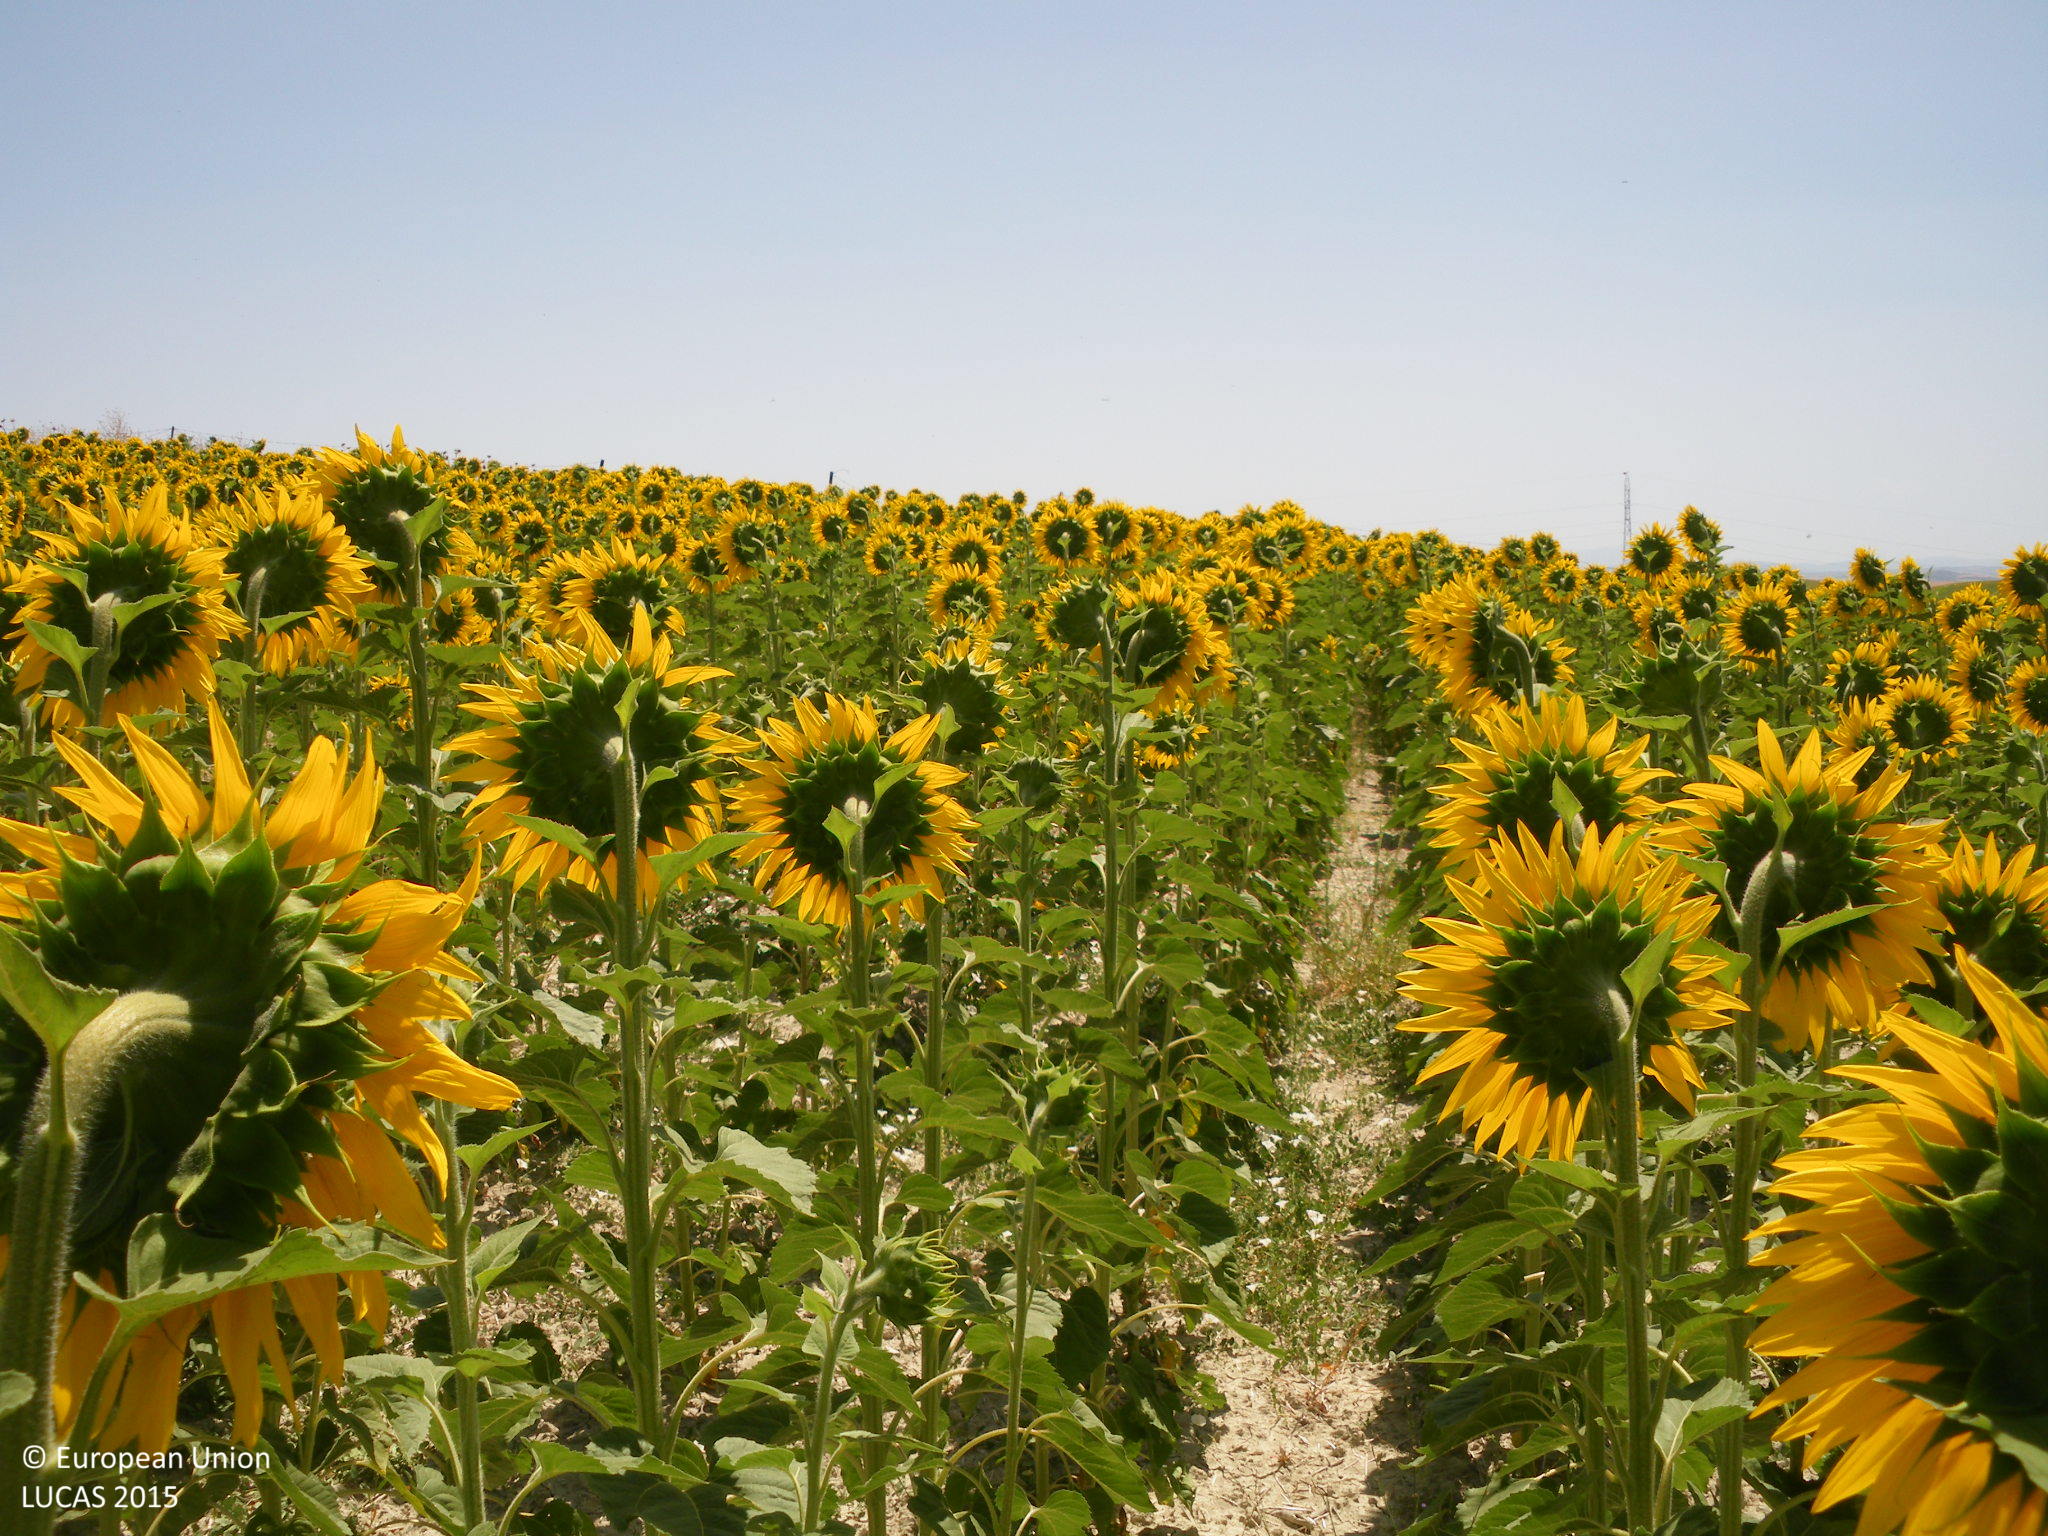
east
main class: Cropland
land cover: Sunflower
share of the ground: > 75 %
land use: Agriculture (excluding fallow land and kitchen gardens)
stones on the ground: < 10 %
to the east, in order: Sunflower; Grass margins; Fences; Grass margins; Sunflower
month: June
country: ES
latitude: 36.7885
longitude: -6.0032
